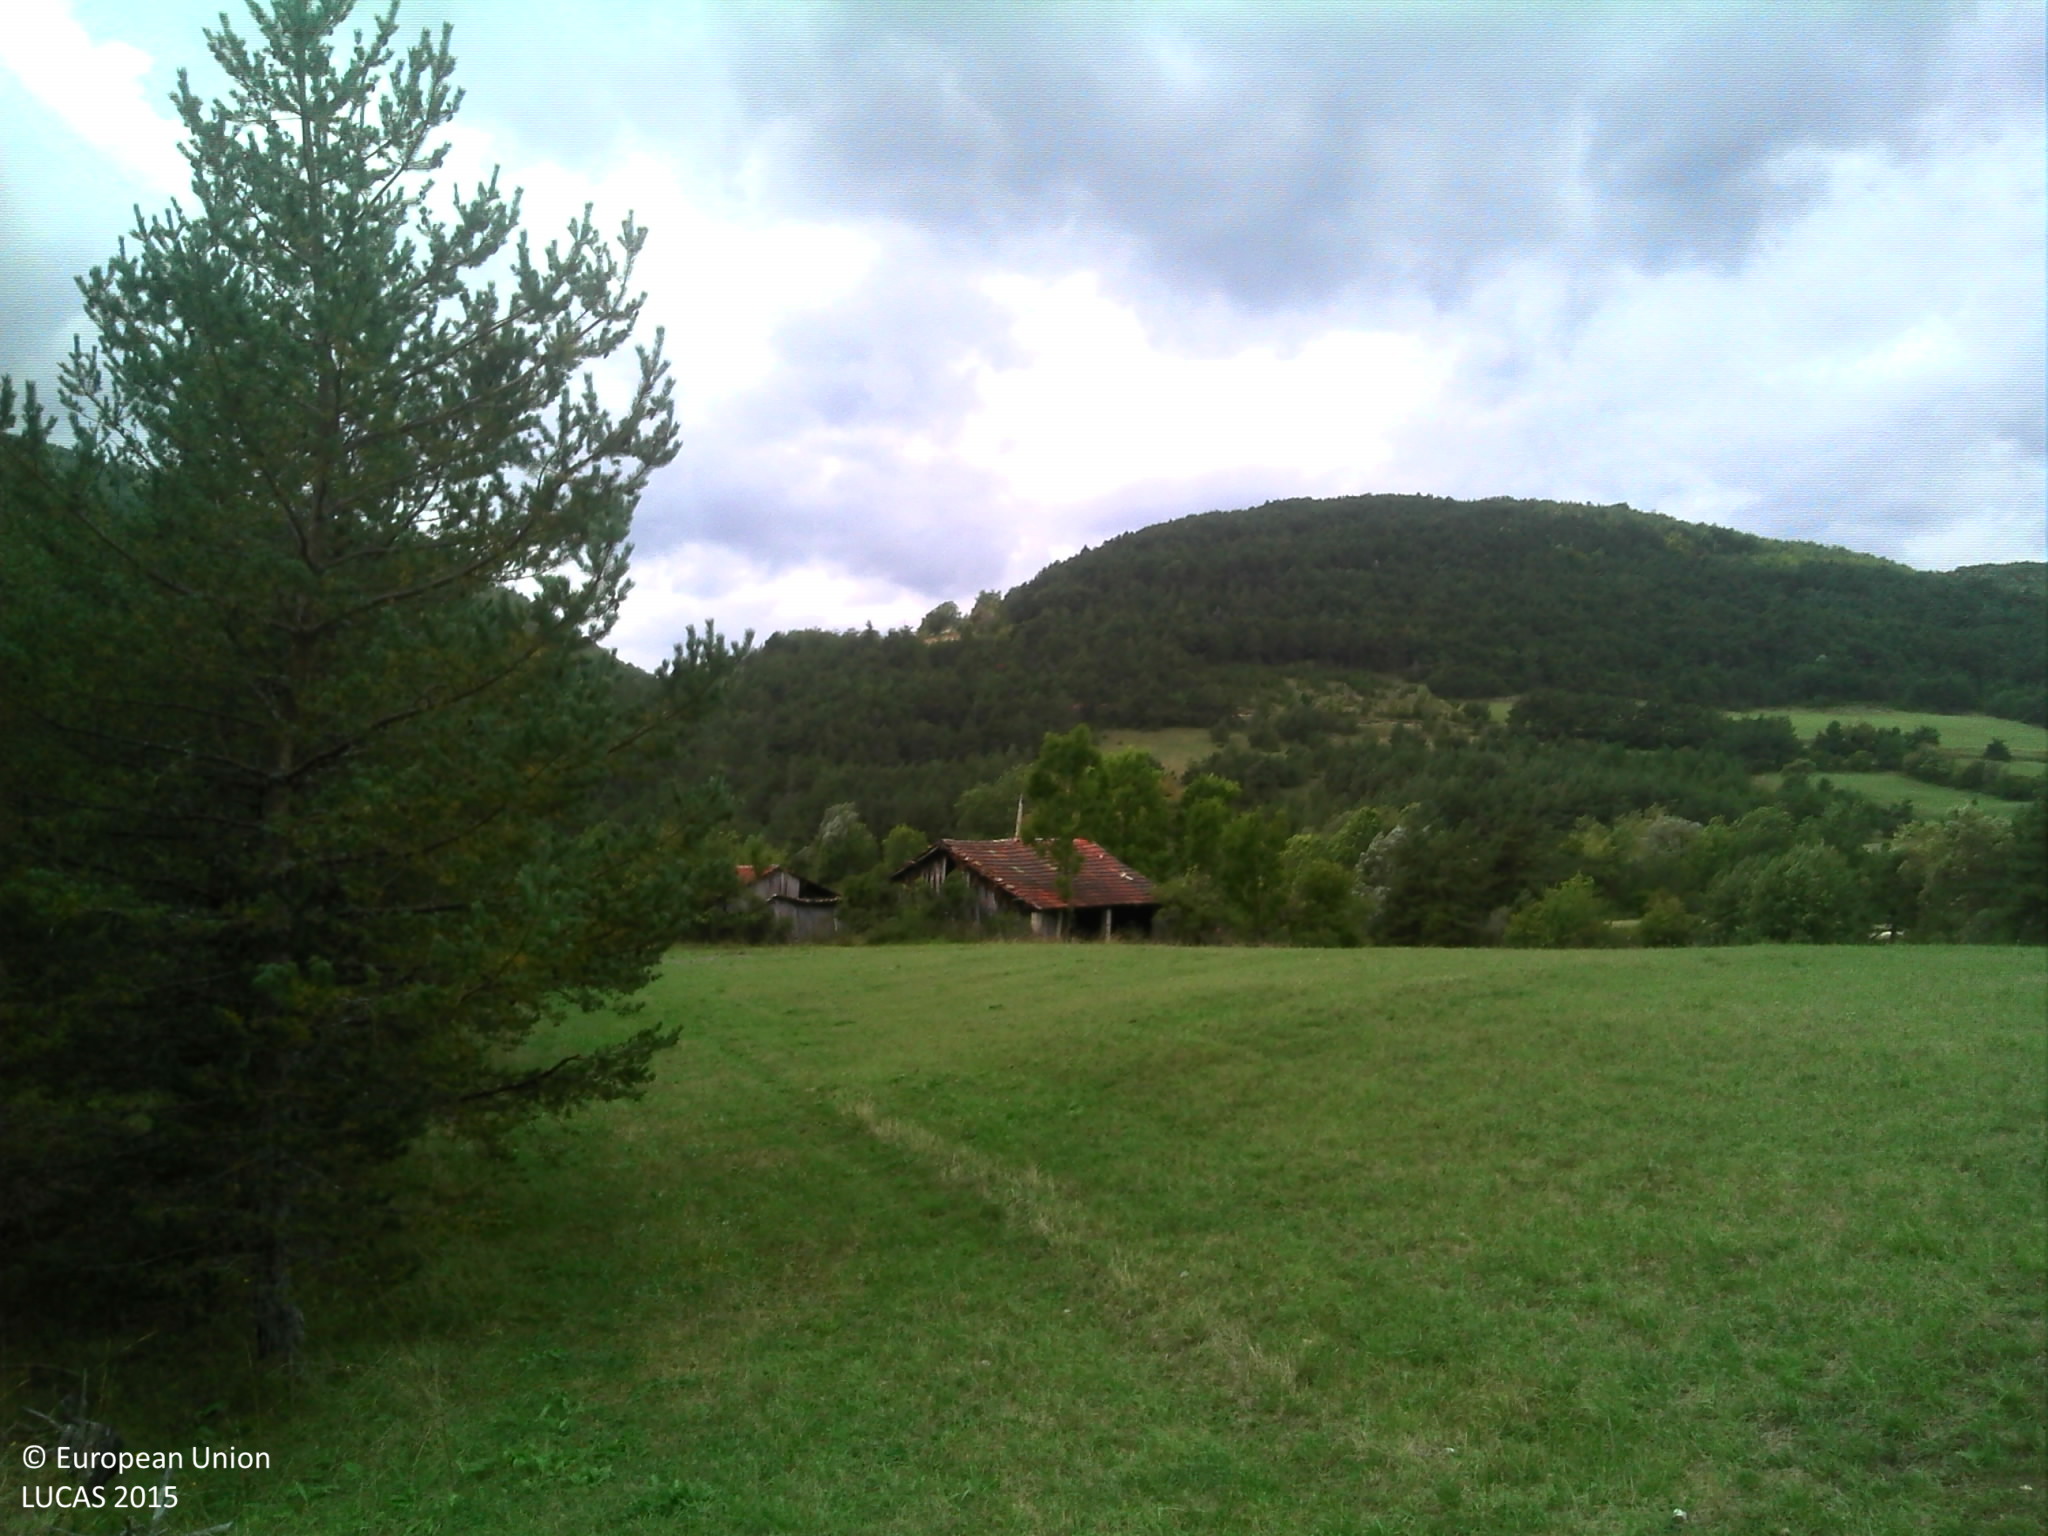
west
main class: Grassland
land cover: Grassland without tree/shrub cover
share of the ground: > 75 %
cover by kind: herbaceous plants 95 %, shrubs 5 %
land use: Agriculture (excluding fallow land and kitchen gardens)
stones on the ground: > 50 %
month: September
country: FR
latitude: 44.5055
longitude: 5.4914
